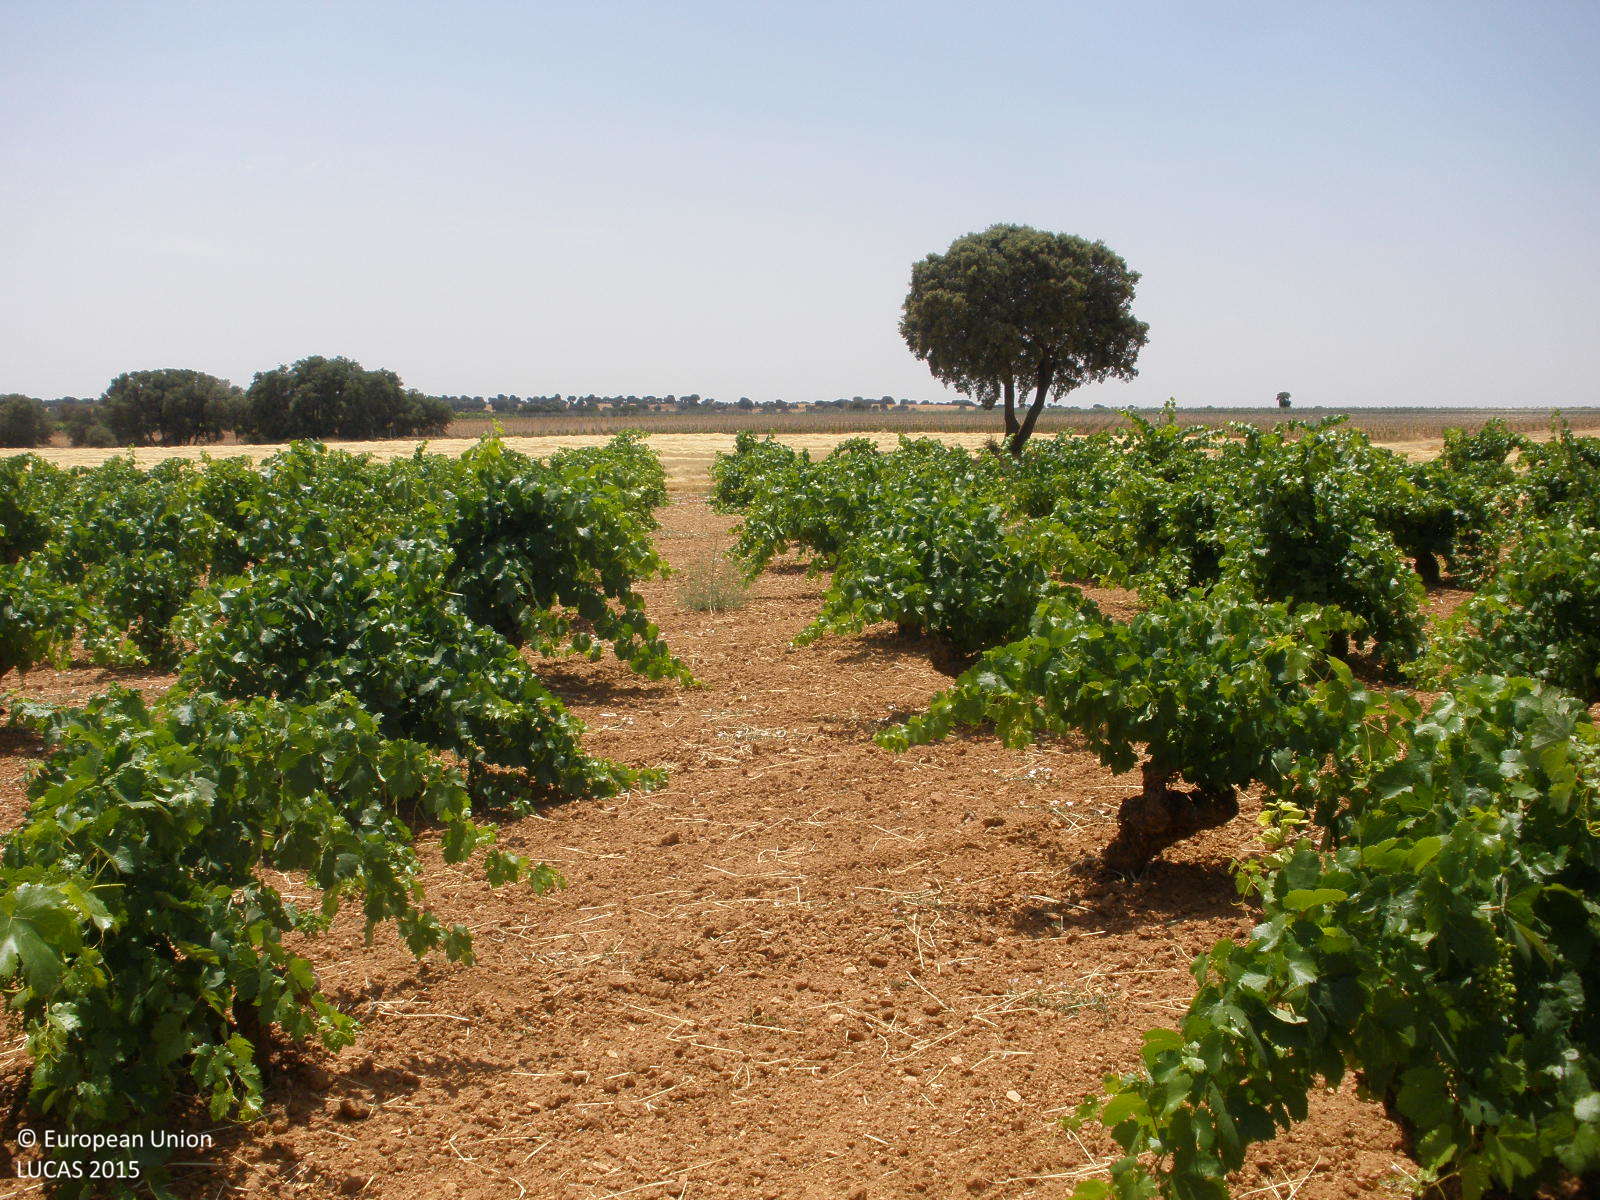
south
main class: Cropland
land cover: Vineyards
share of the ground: 50 - 75 %
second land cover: Other bare soil
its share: > 75 %
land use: Agriculture (excluding fallow land and kitchen gardens)
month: July
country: ES
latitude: 39.8980
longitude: -3.2295
